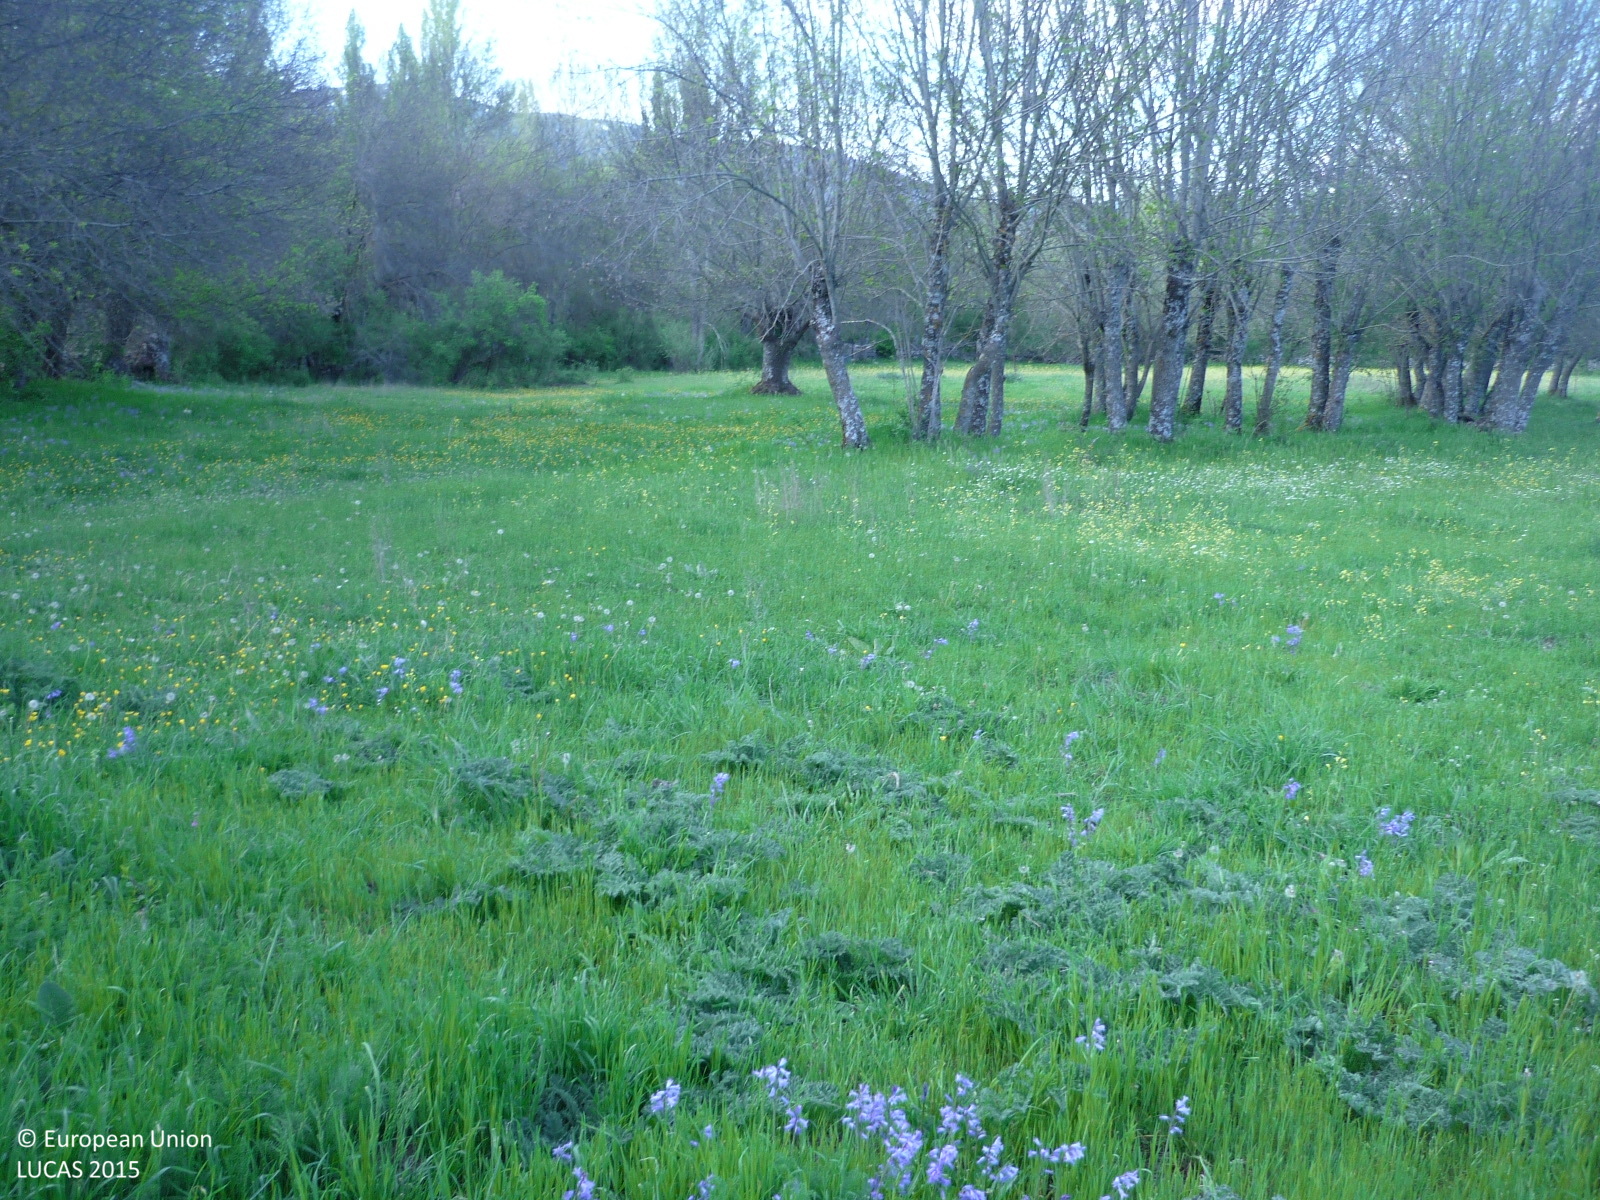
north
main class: Grassland
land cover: Grassland with sparse tree/shrub cover
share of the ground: > 75 %
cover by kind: herbaceous plants 90 %, broadleaved forest trees 5 %, shrubs 5 %
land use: Semi-natural and natural areas not in use
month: May
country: ES
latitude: 40.9098
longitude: -3.8534
